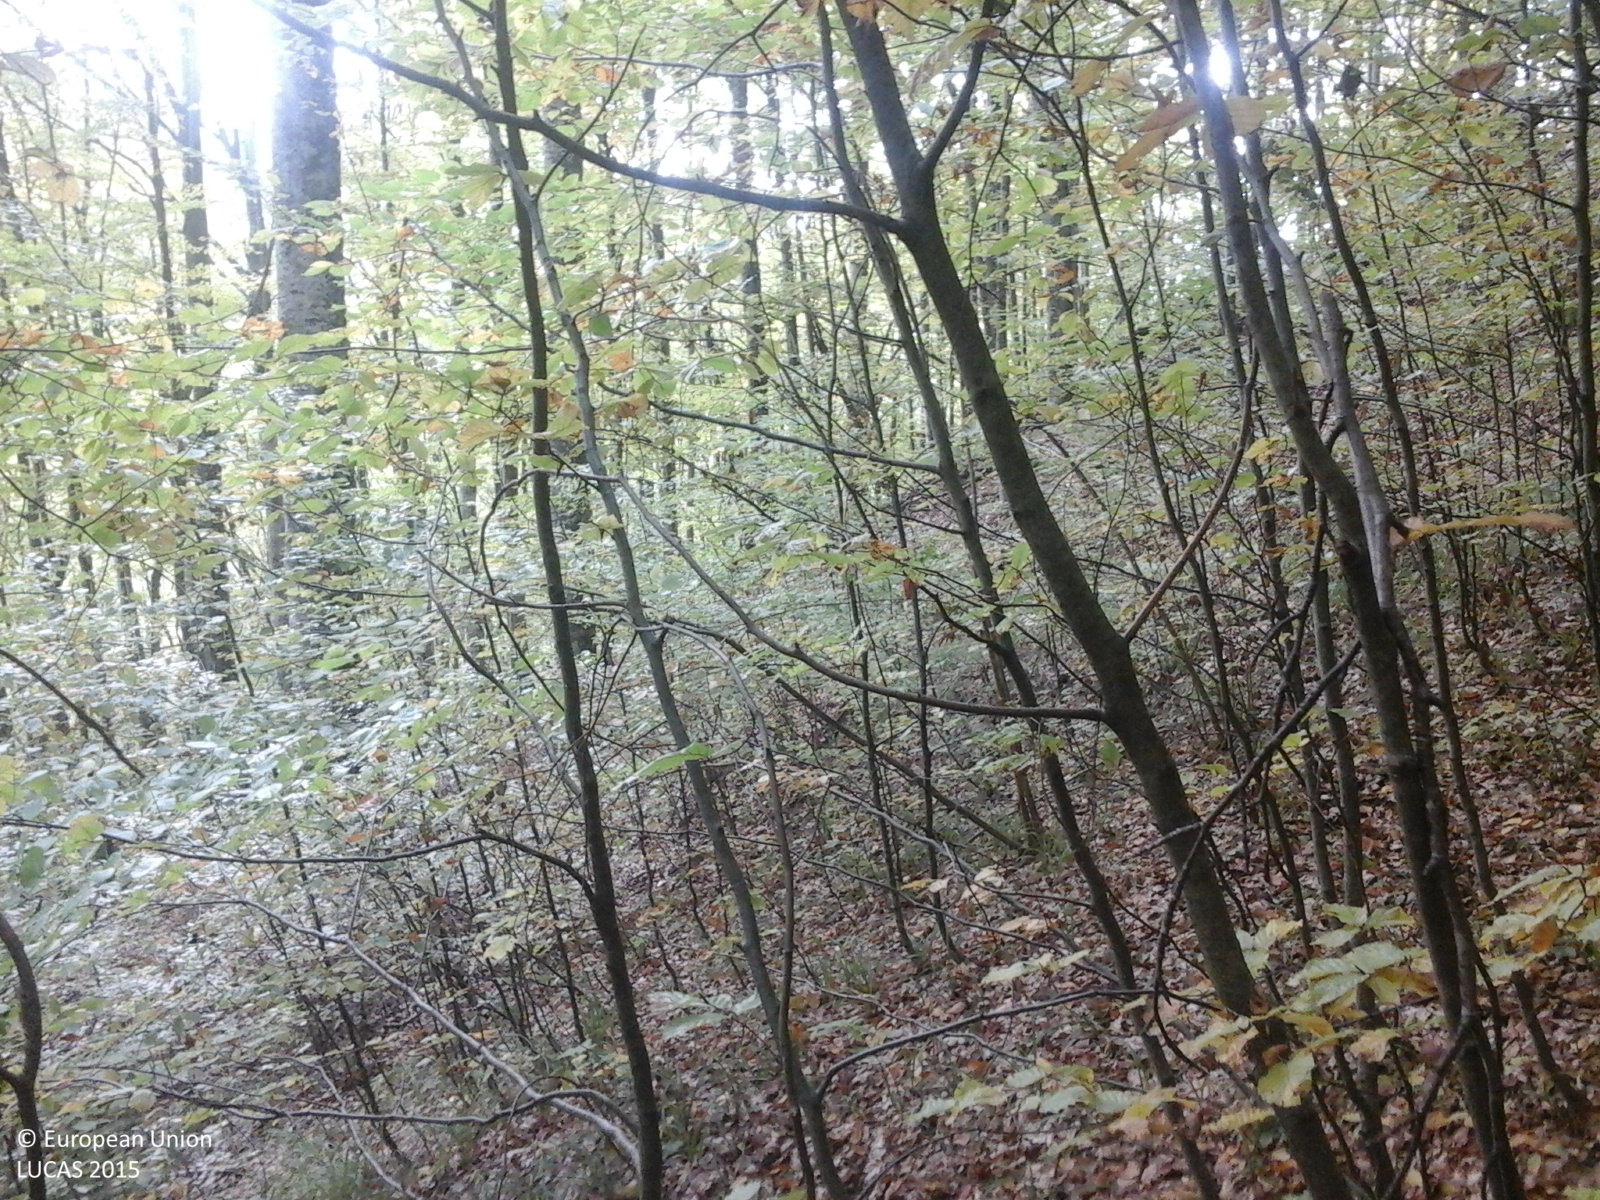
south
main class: Woodland
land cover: Broadleaved woodland
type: beech forest
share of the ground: > 75 %
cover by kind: broadleaved forest trees 100 %
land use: Forestry
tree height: > 5 m
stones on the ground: 10 - 25 %
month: October
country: RO
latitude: 46.5859
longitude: 25.2558
